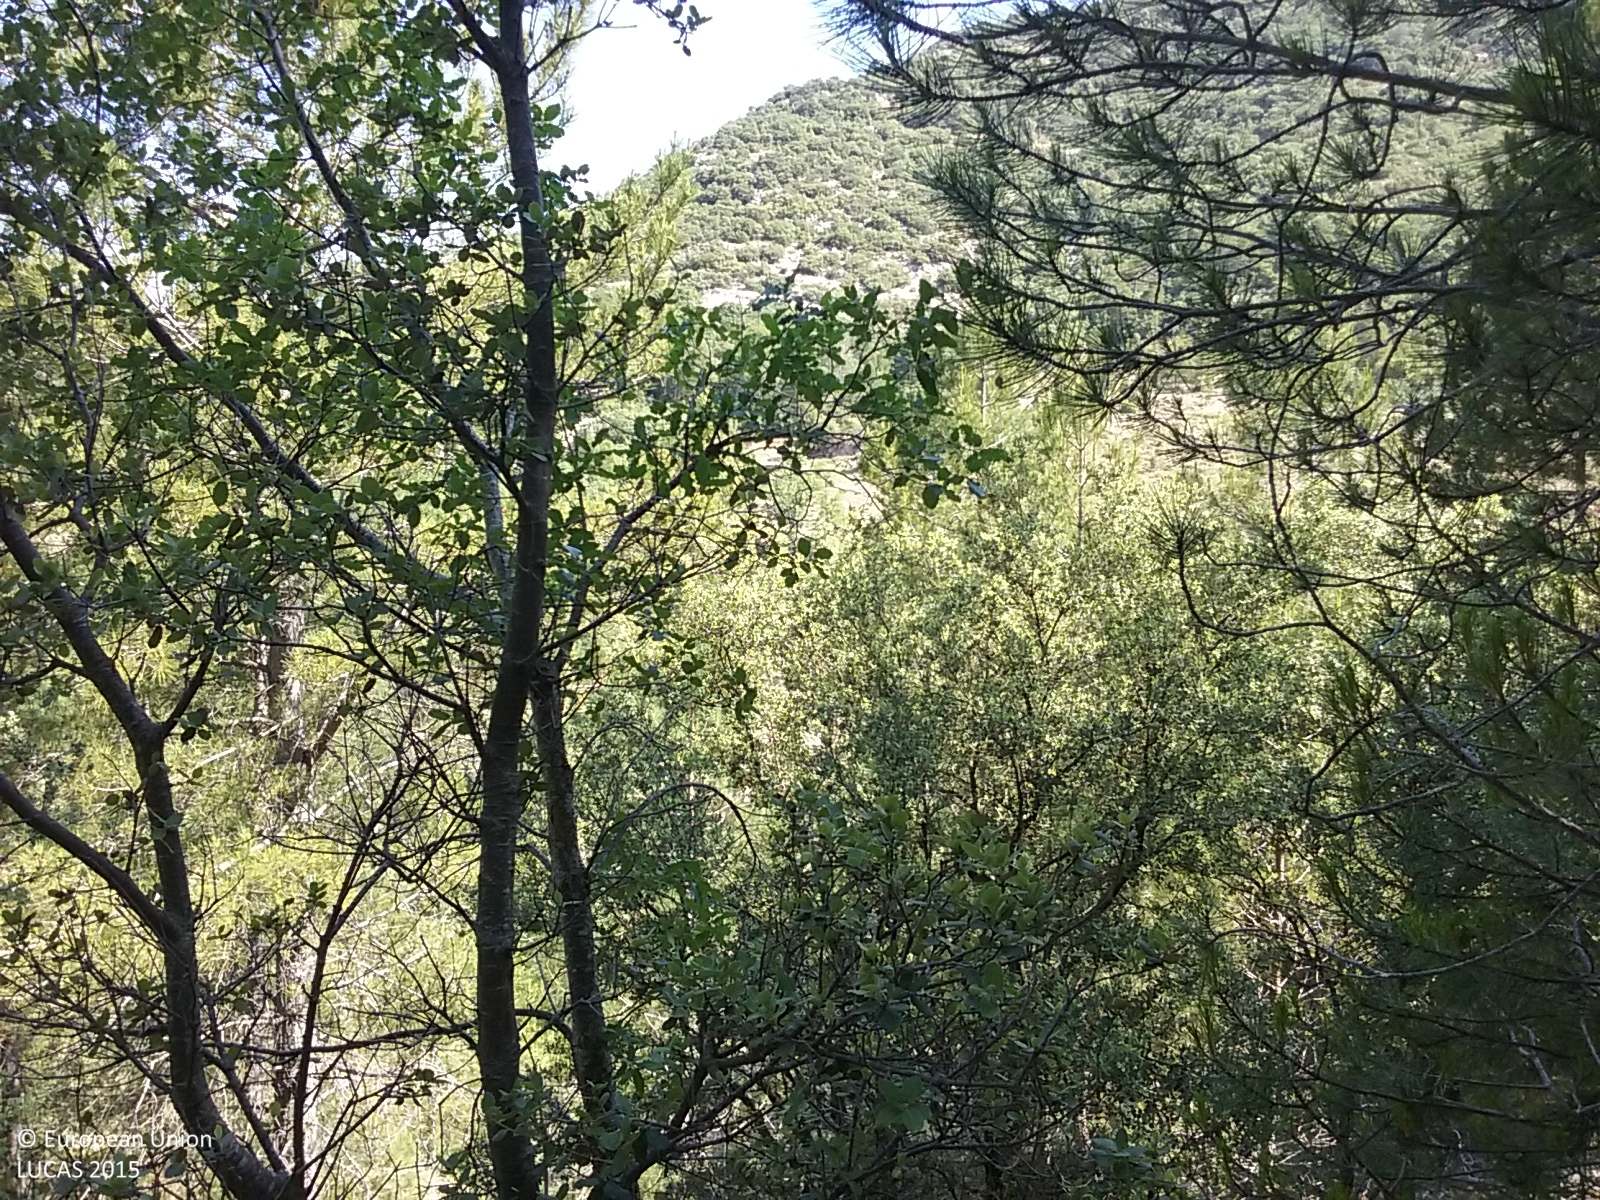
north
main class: Woodland
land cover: Pine dominated mixed woodland
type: coniferous forest of the mediterranean region
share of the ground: > 75 %
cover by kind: coniferous forest trees 45 %, broadleaved forest trees 35 %, herbaceous plants 10 %, shrubs 5 %, unconsolidated bare surface 5 %
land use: Forestry
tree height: > 5 m
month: June
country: ES
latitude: 40.7014
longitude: -0.0084
